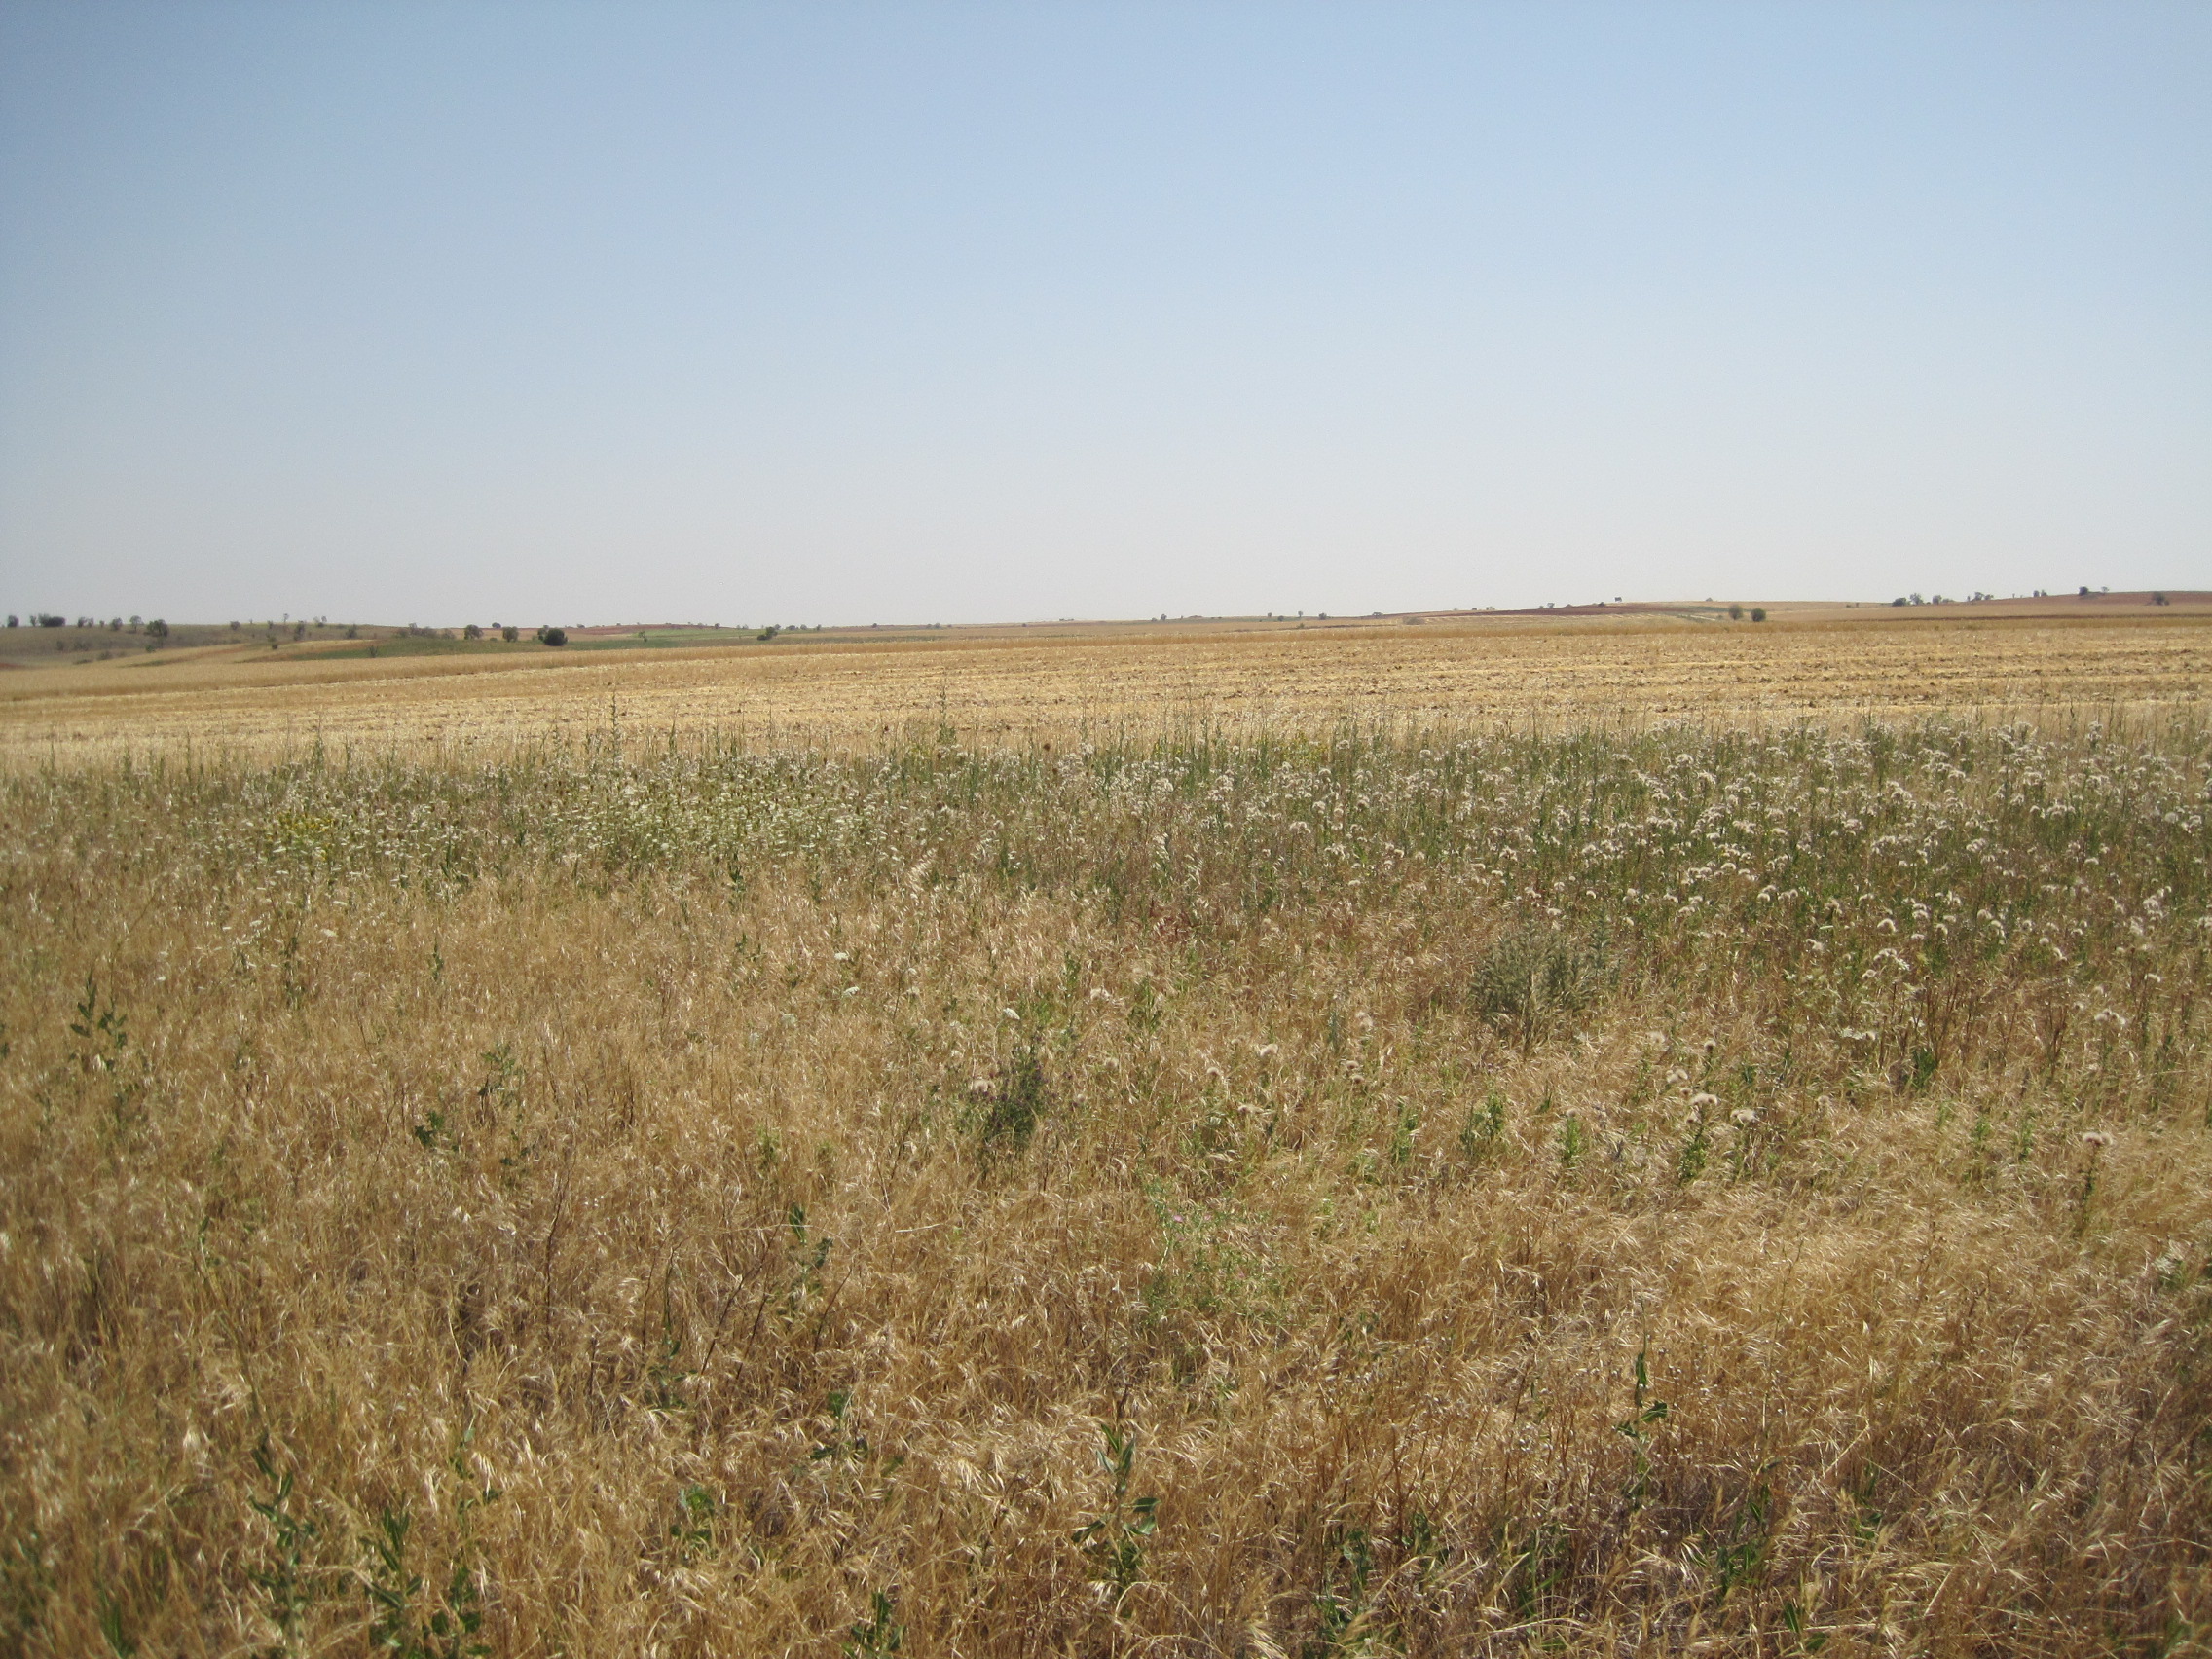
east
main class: Grassland
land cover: Spontaneously vegetated surfaces
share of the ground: > 75 %
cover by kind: herbaceous plants 100 %
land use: Abandoned areas
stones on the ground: 25 - 50 %
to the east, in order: Spontaneously vegetated surfaces; Grass margins; Other bare soil; Grass margins; Common wheat; Grass margins; Common wheat
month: July
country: ES
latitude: 41.7023
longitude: -5.4284
